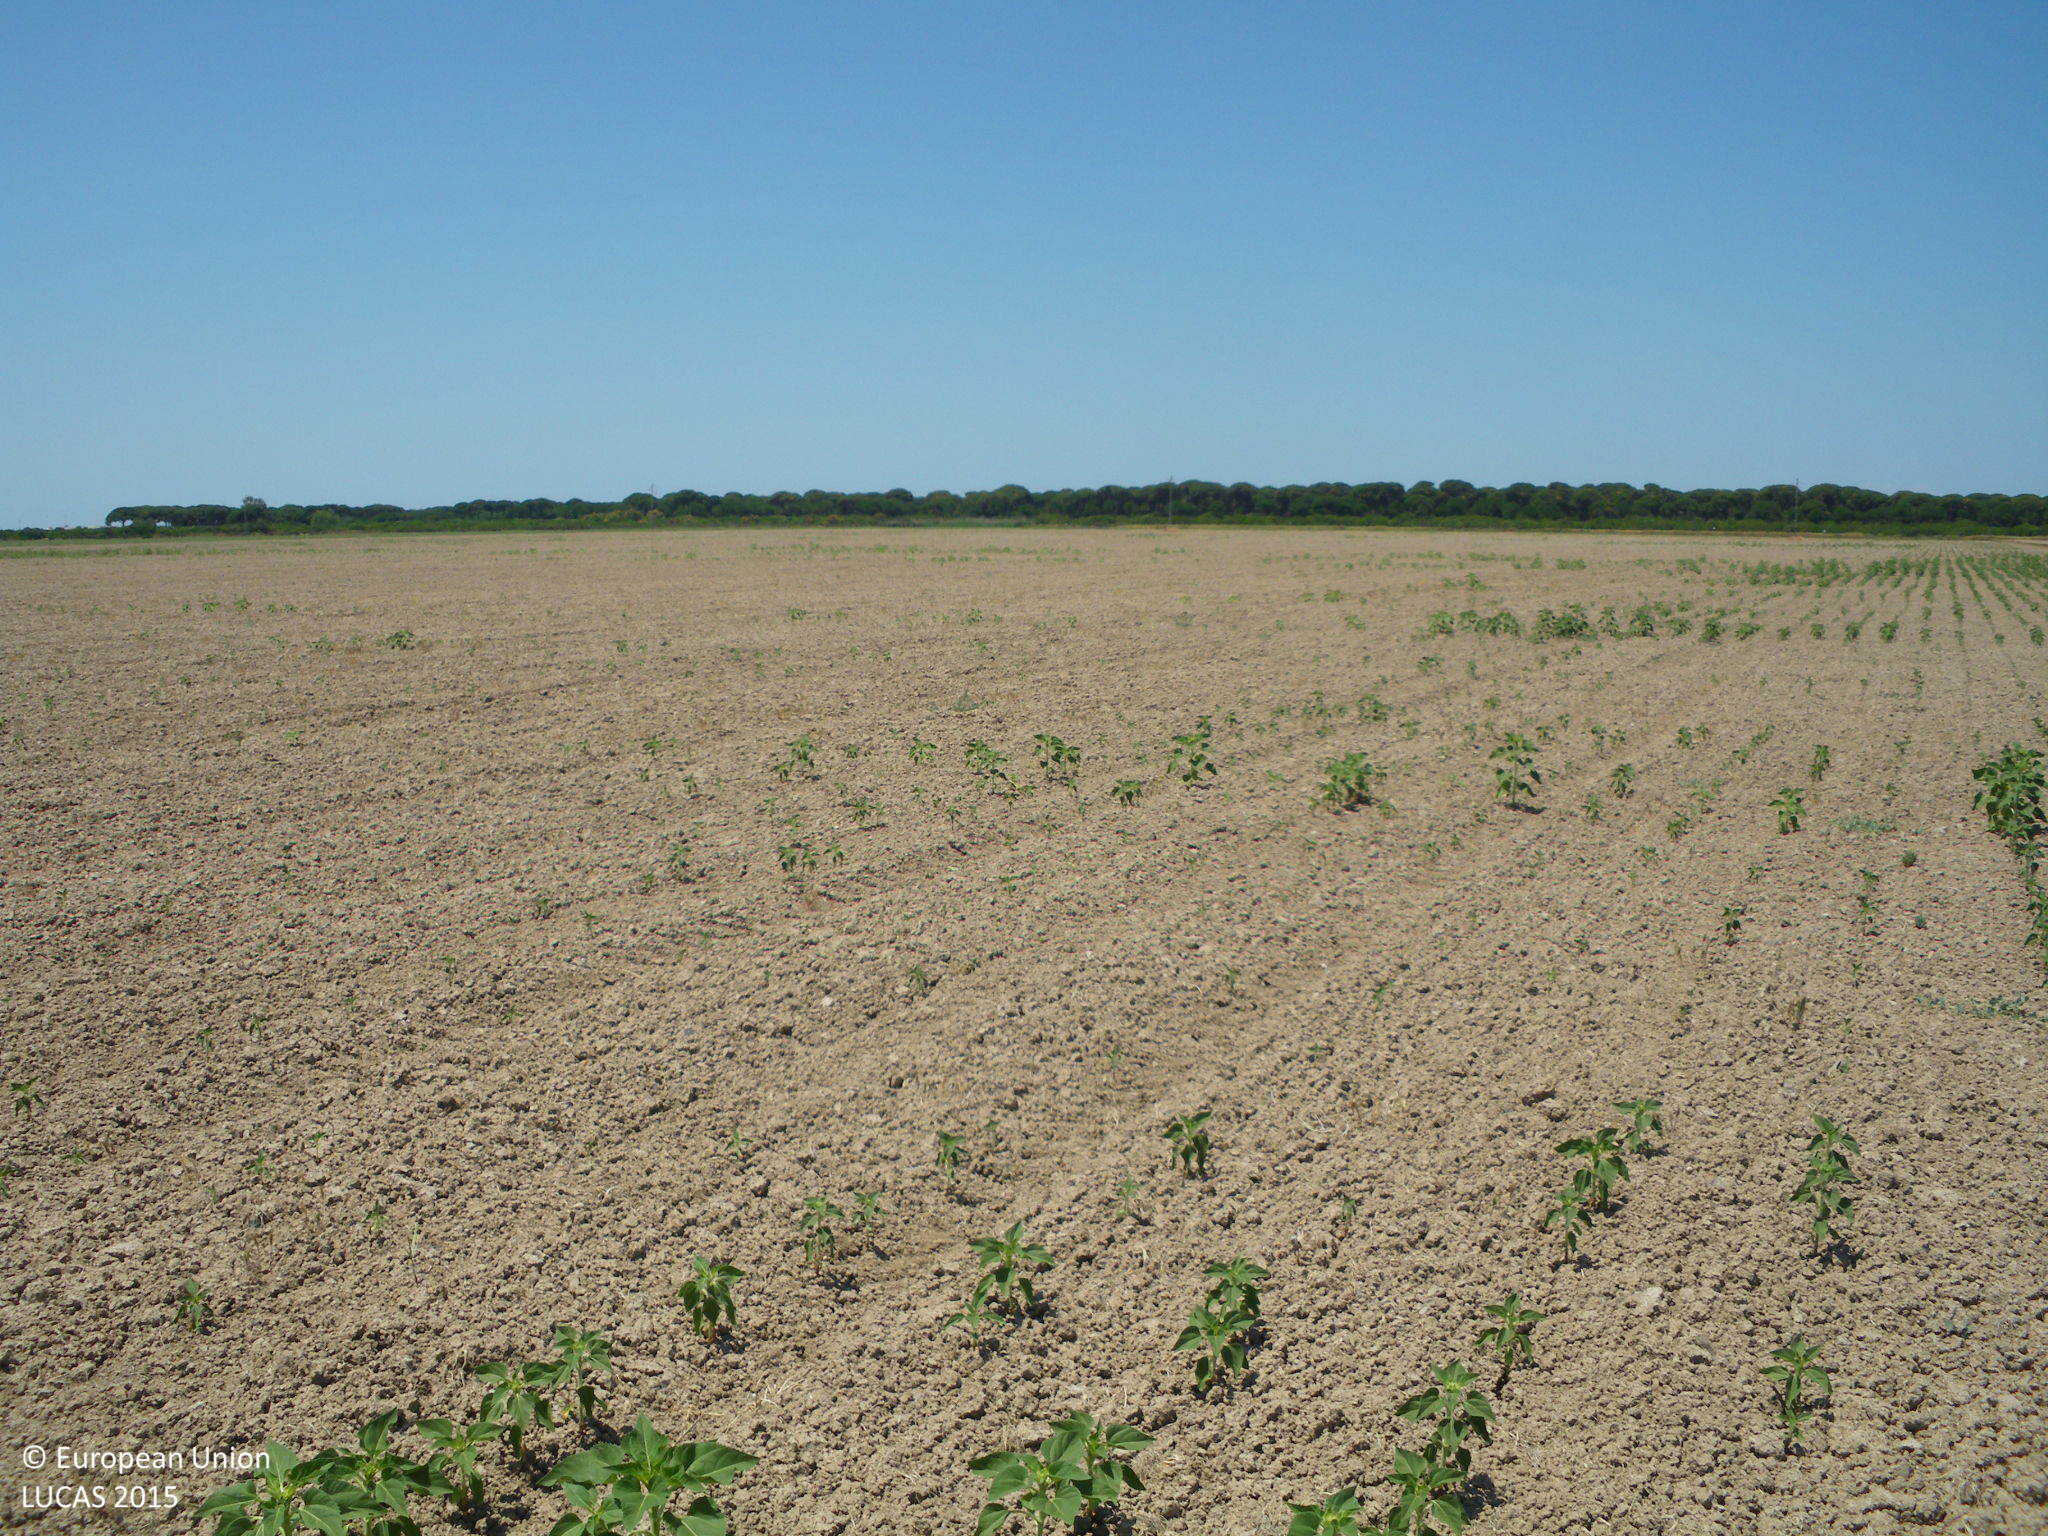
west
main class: Cropland
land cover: Sunflower
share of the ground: < 10 %
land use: Agriculture (excluding fallow land and kitchen gardens)
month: May
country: ES
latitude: 36.8492
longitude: -6.2909
